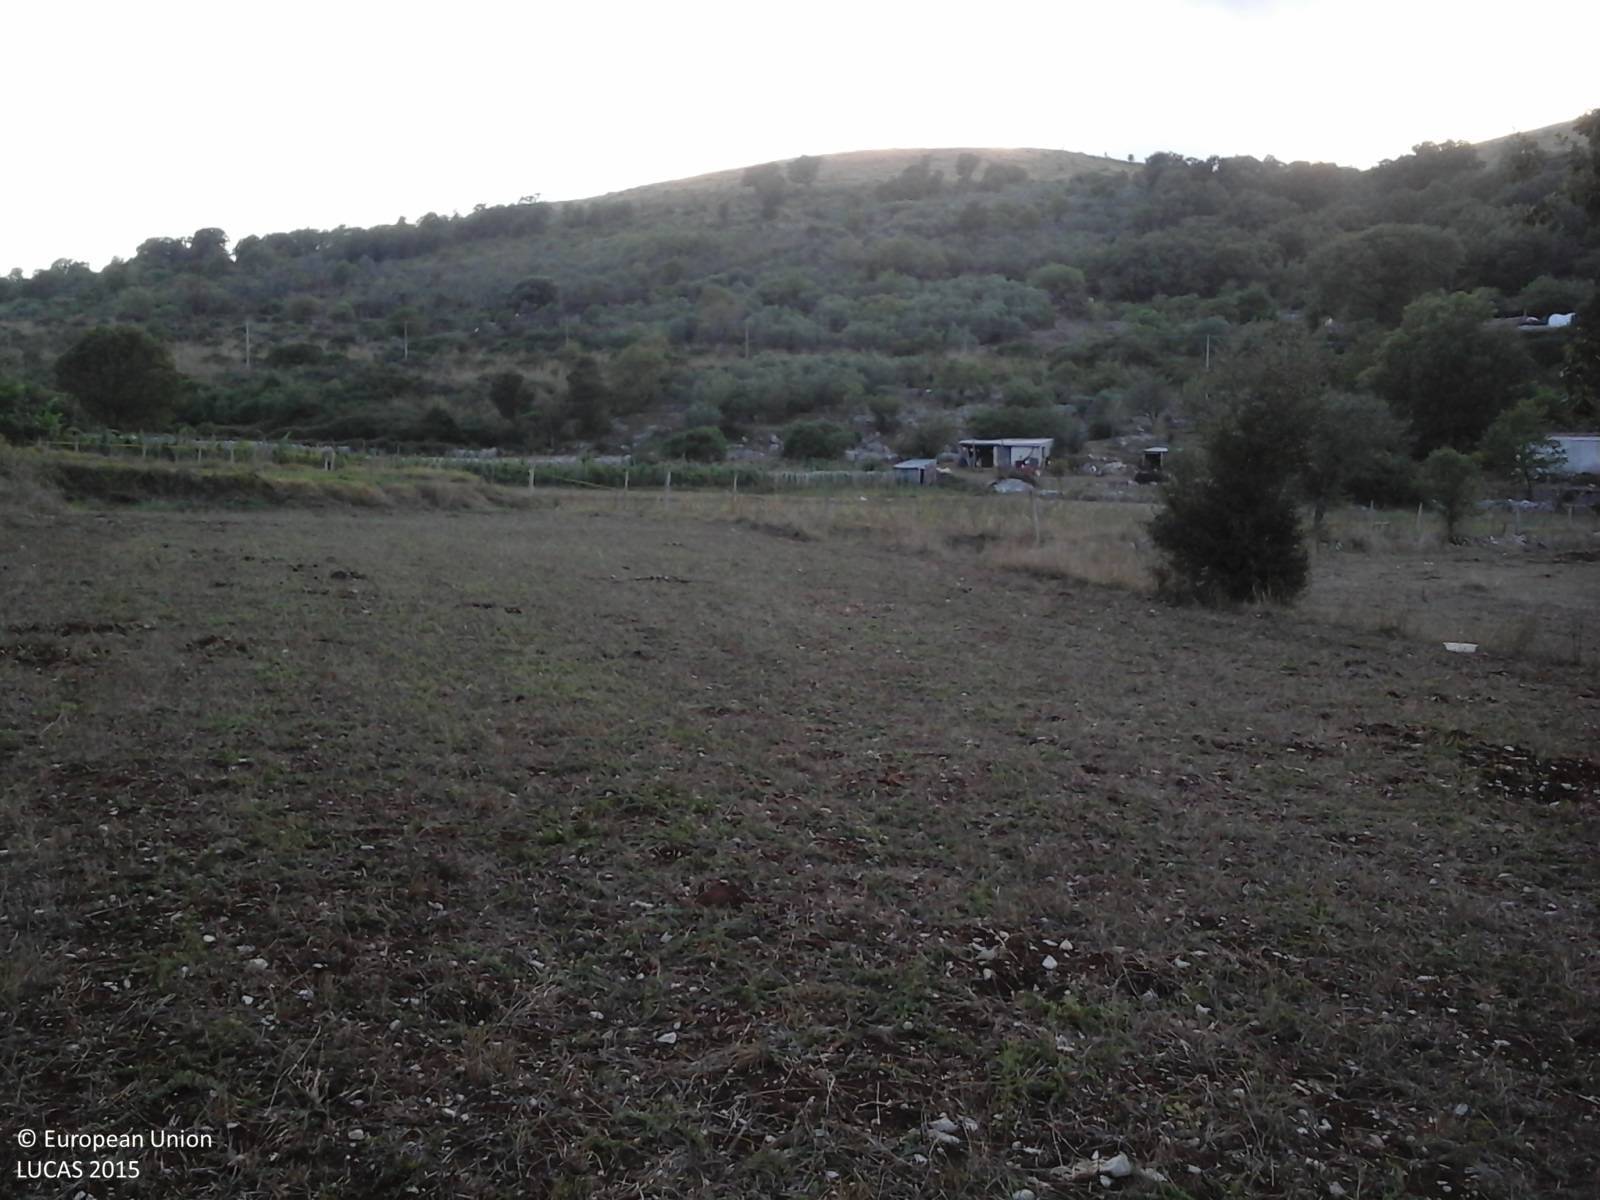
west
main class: Cropland
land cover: Temporary grasslands
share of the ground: 50 - 75 %
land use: Agriculture (excluding fallow land and kitchen gardens)
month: August
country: IT
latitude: 41.3830
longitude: 13.4661
